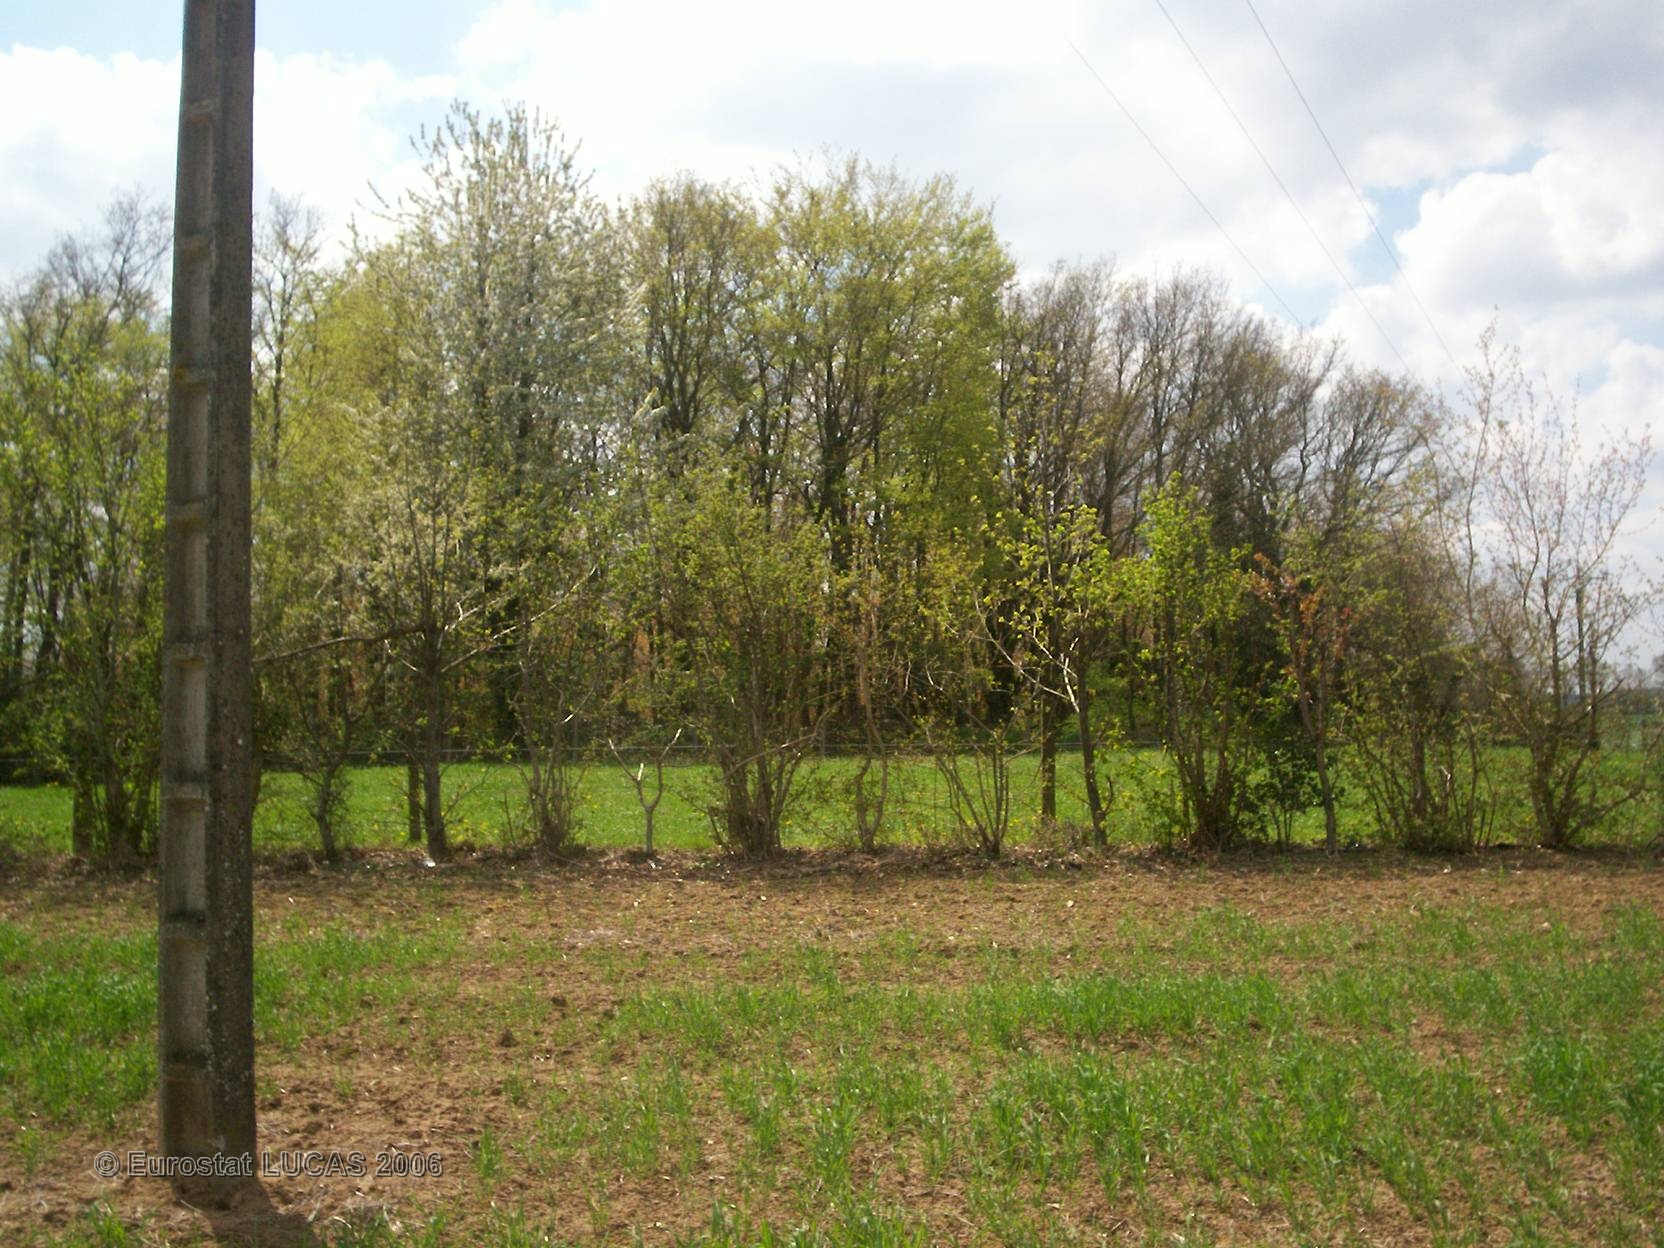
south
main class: Cropland
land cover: Rye
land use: Agriculture (excluding fallow land and kitchen gardens)
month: April
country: FR
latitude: 48.2342
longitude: -0.2501
